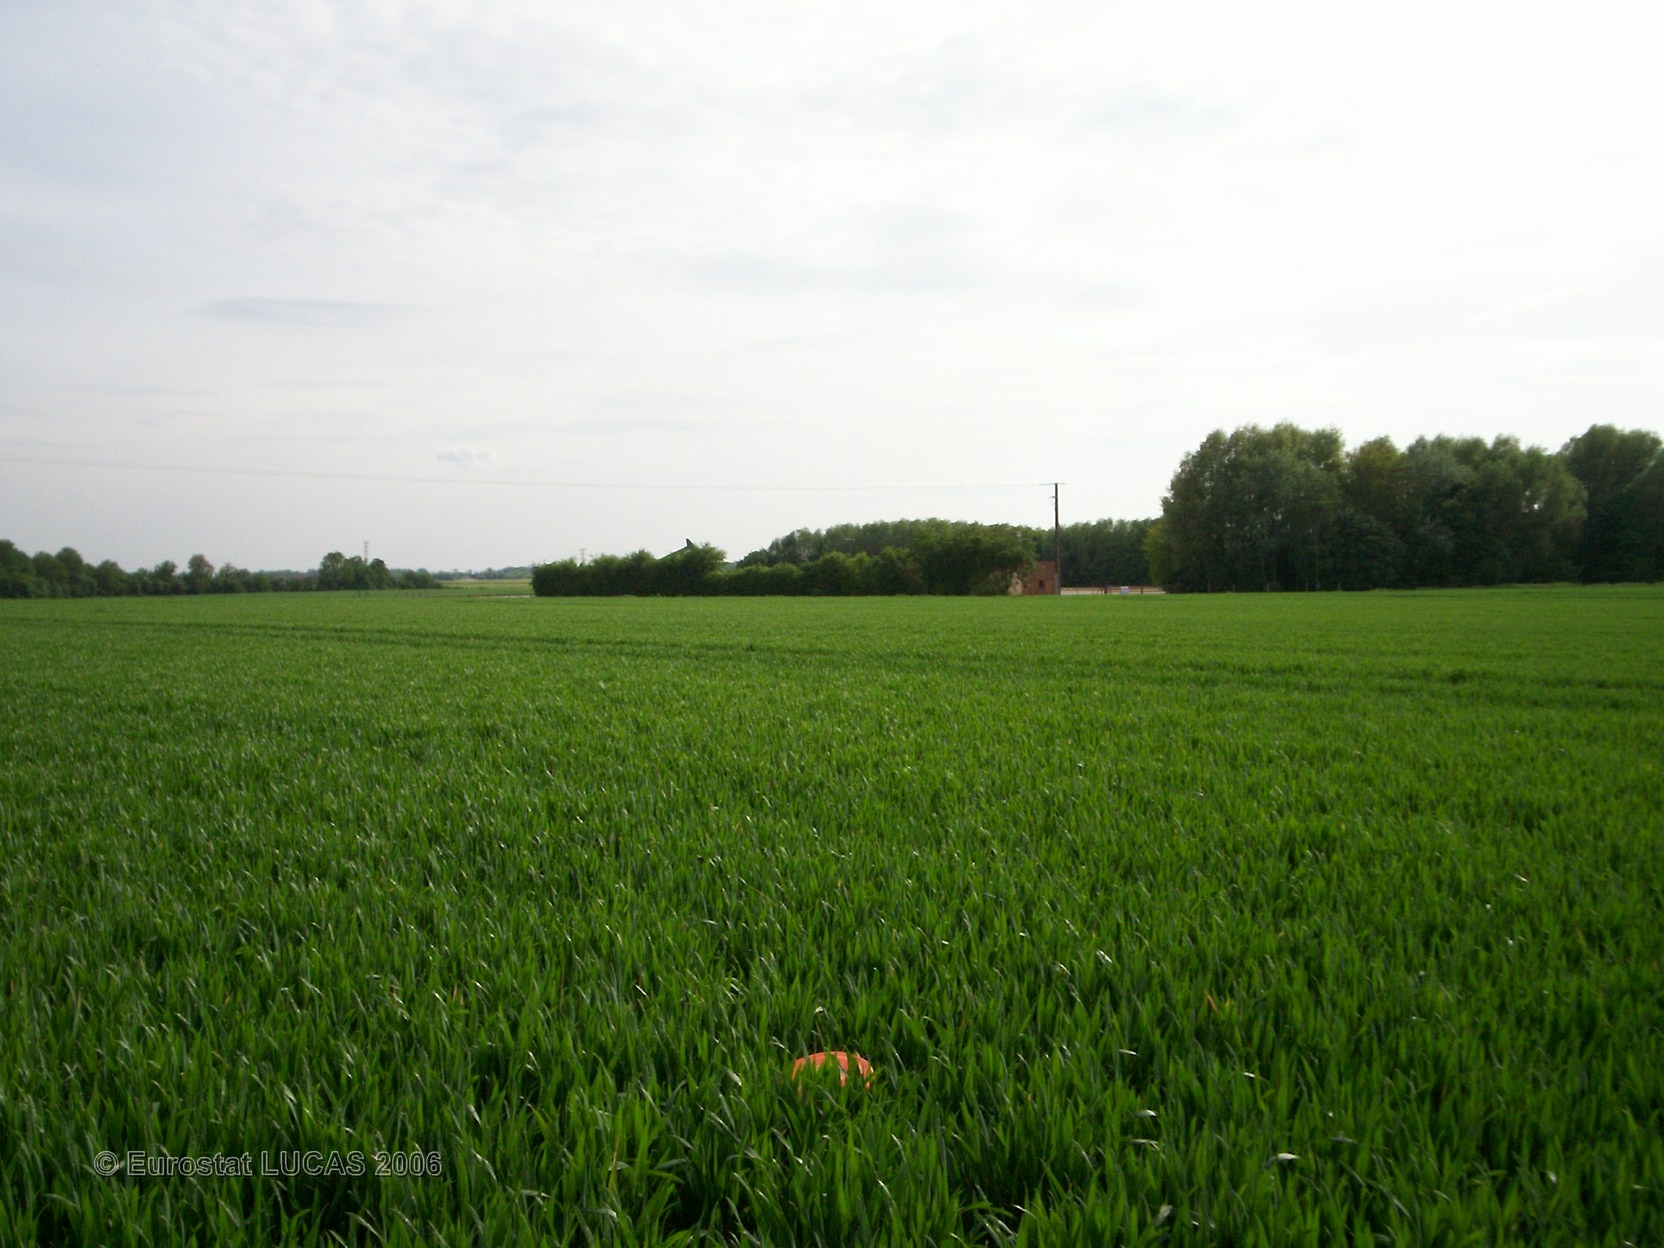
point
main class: Cropland
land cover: Common wheat
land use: Agriculture (excluding fallow land and kitchen gardens)
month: May
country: FR
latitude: 48.6050
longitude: 2.8439
